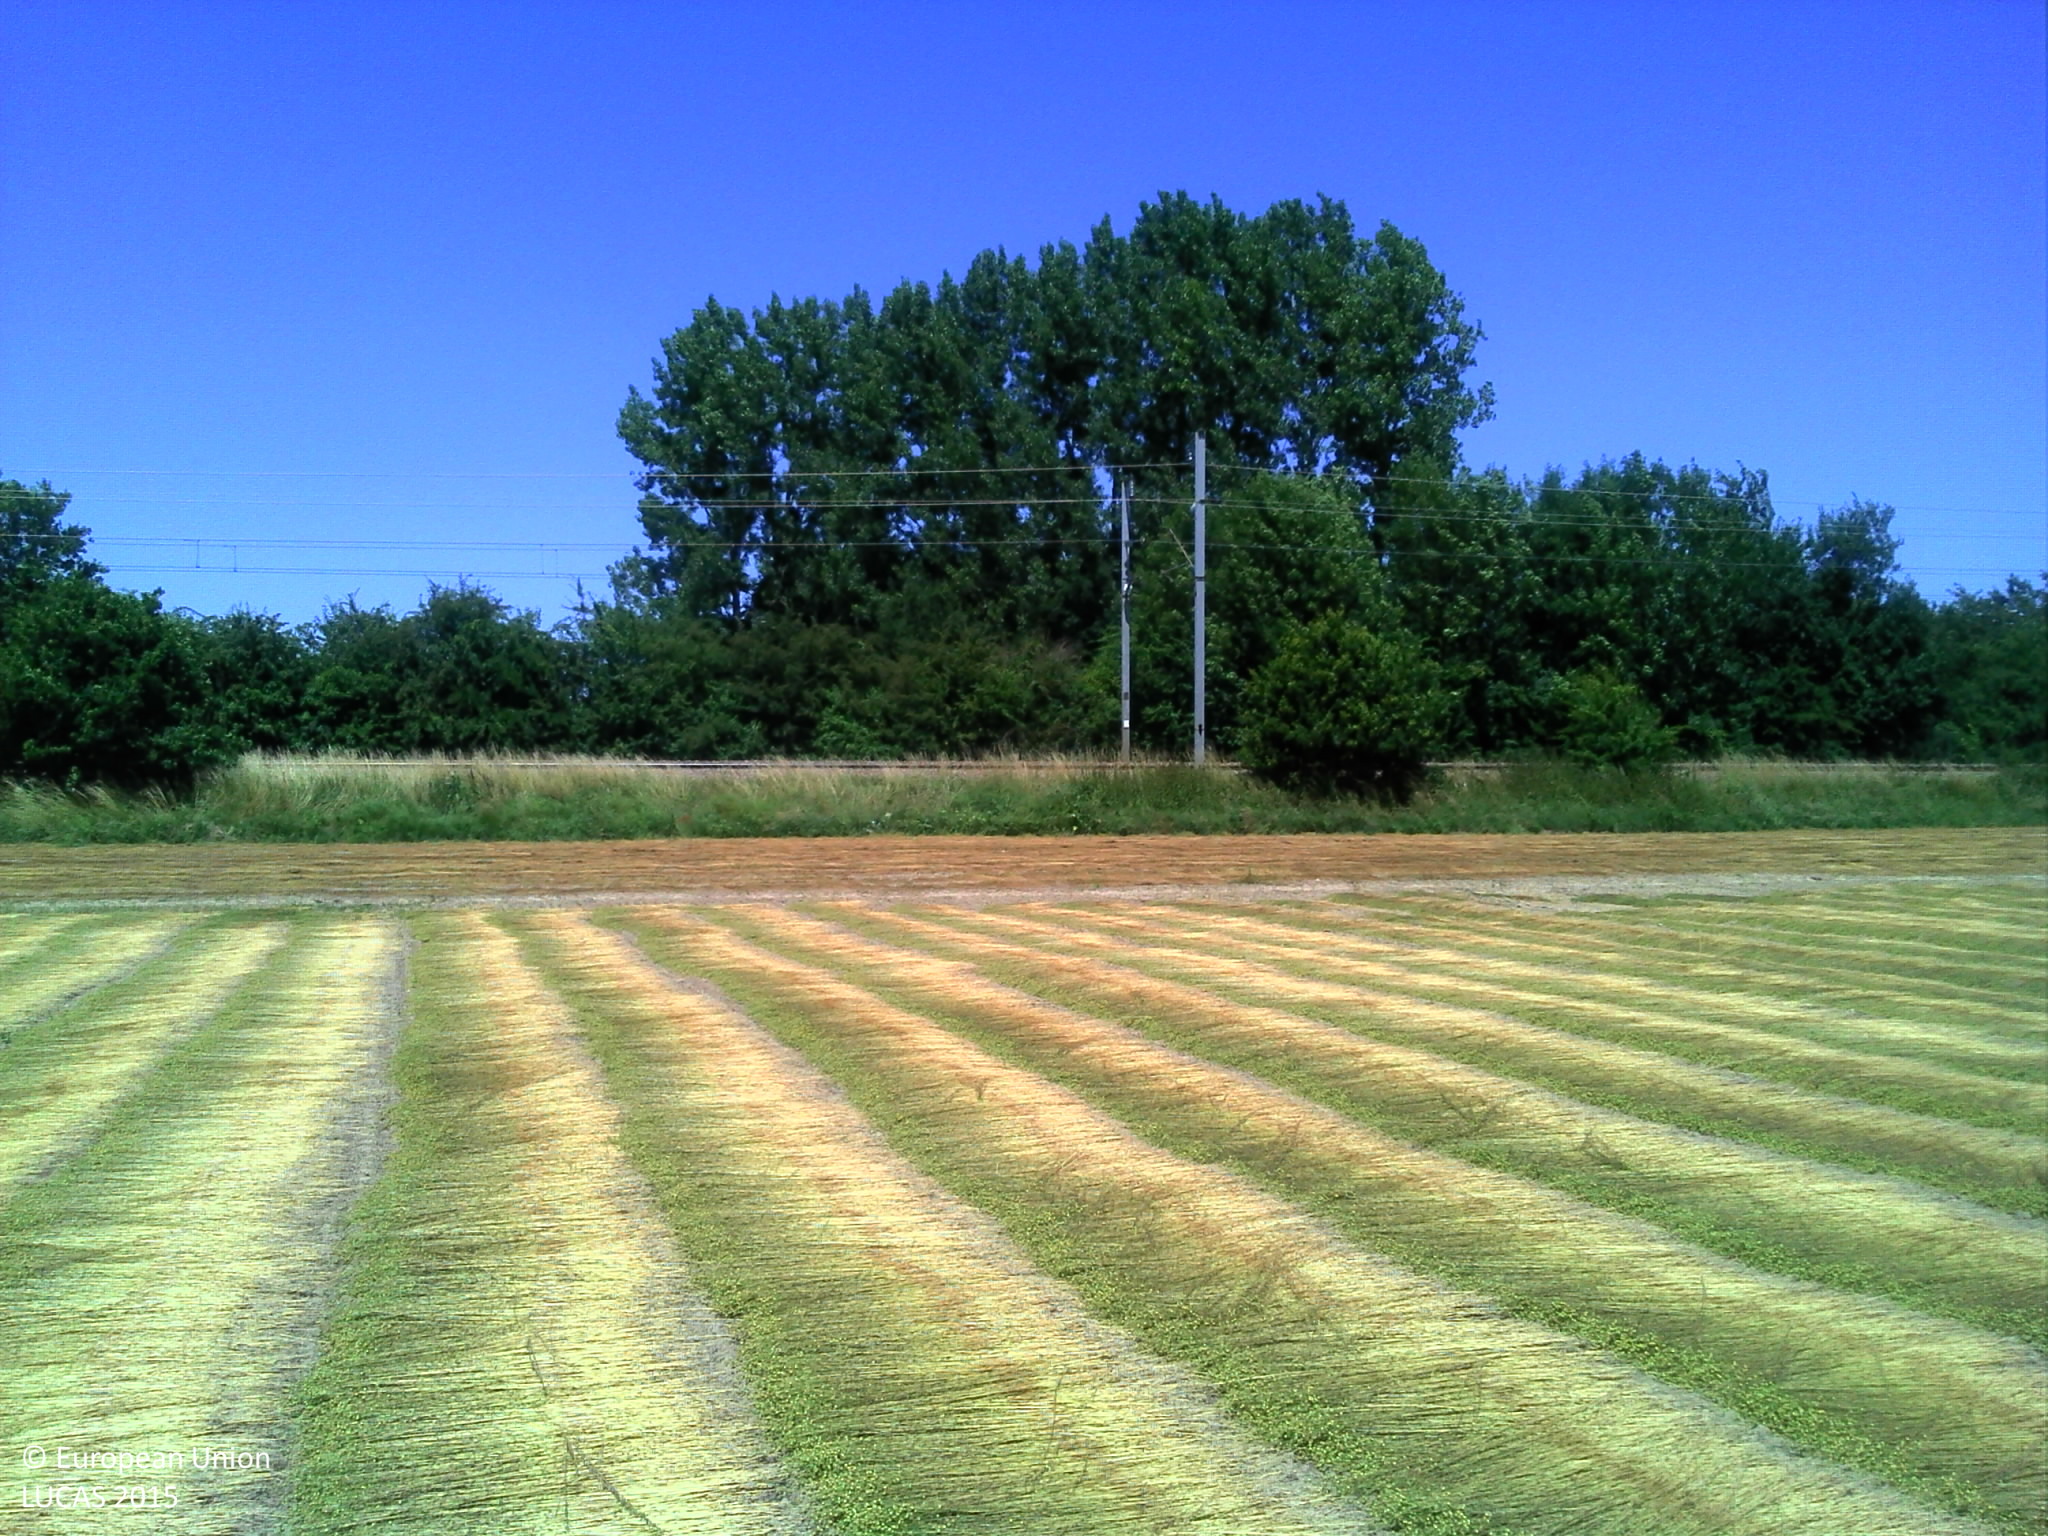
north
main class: Cropland
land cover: Other fibre and oleaginous crops
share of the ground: 25 - 50 %
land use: Agriculture (excluding fallow land and kitchen gardens)
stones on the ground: < 10 %
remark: Harvested field
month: July
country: FR
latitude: 49.0793
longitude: 0.4862
